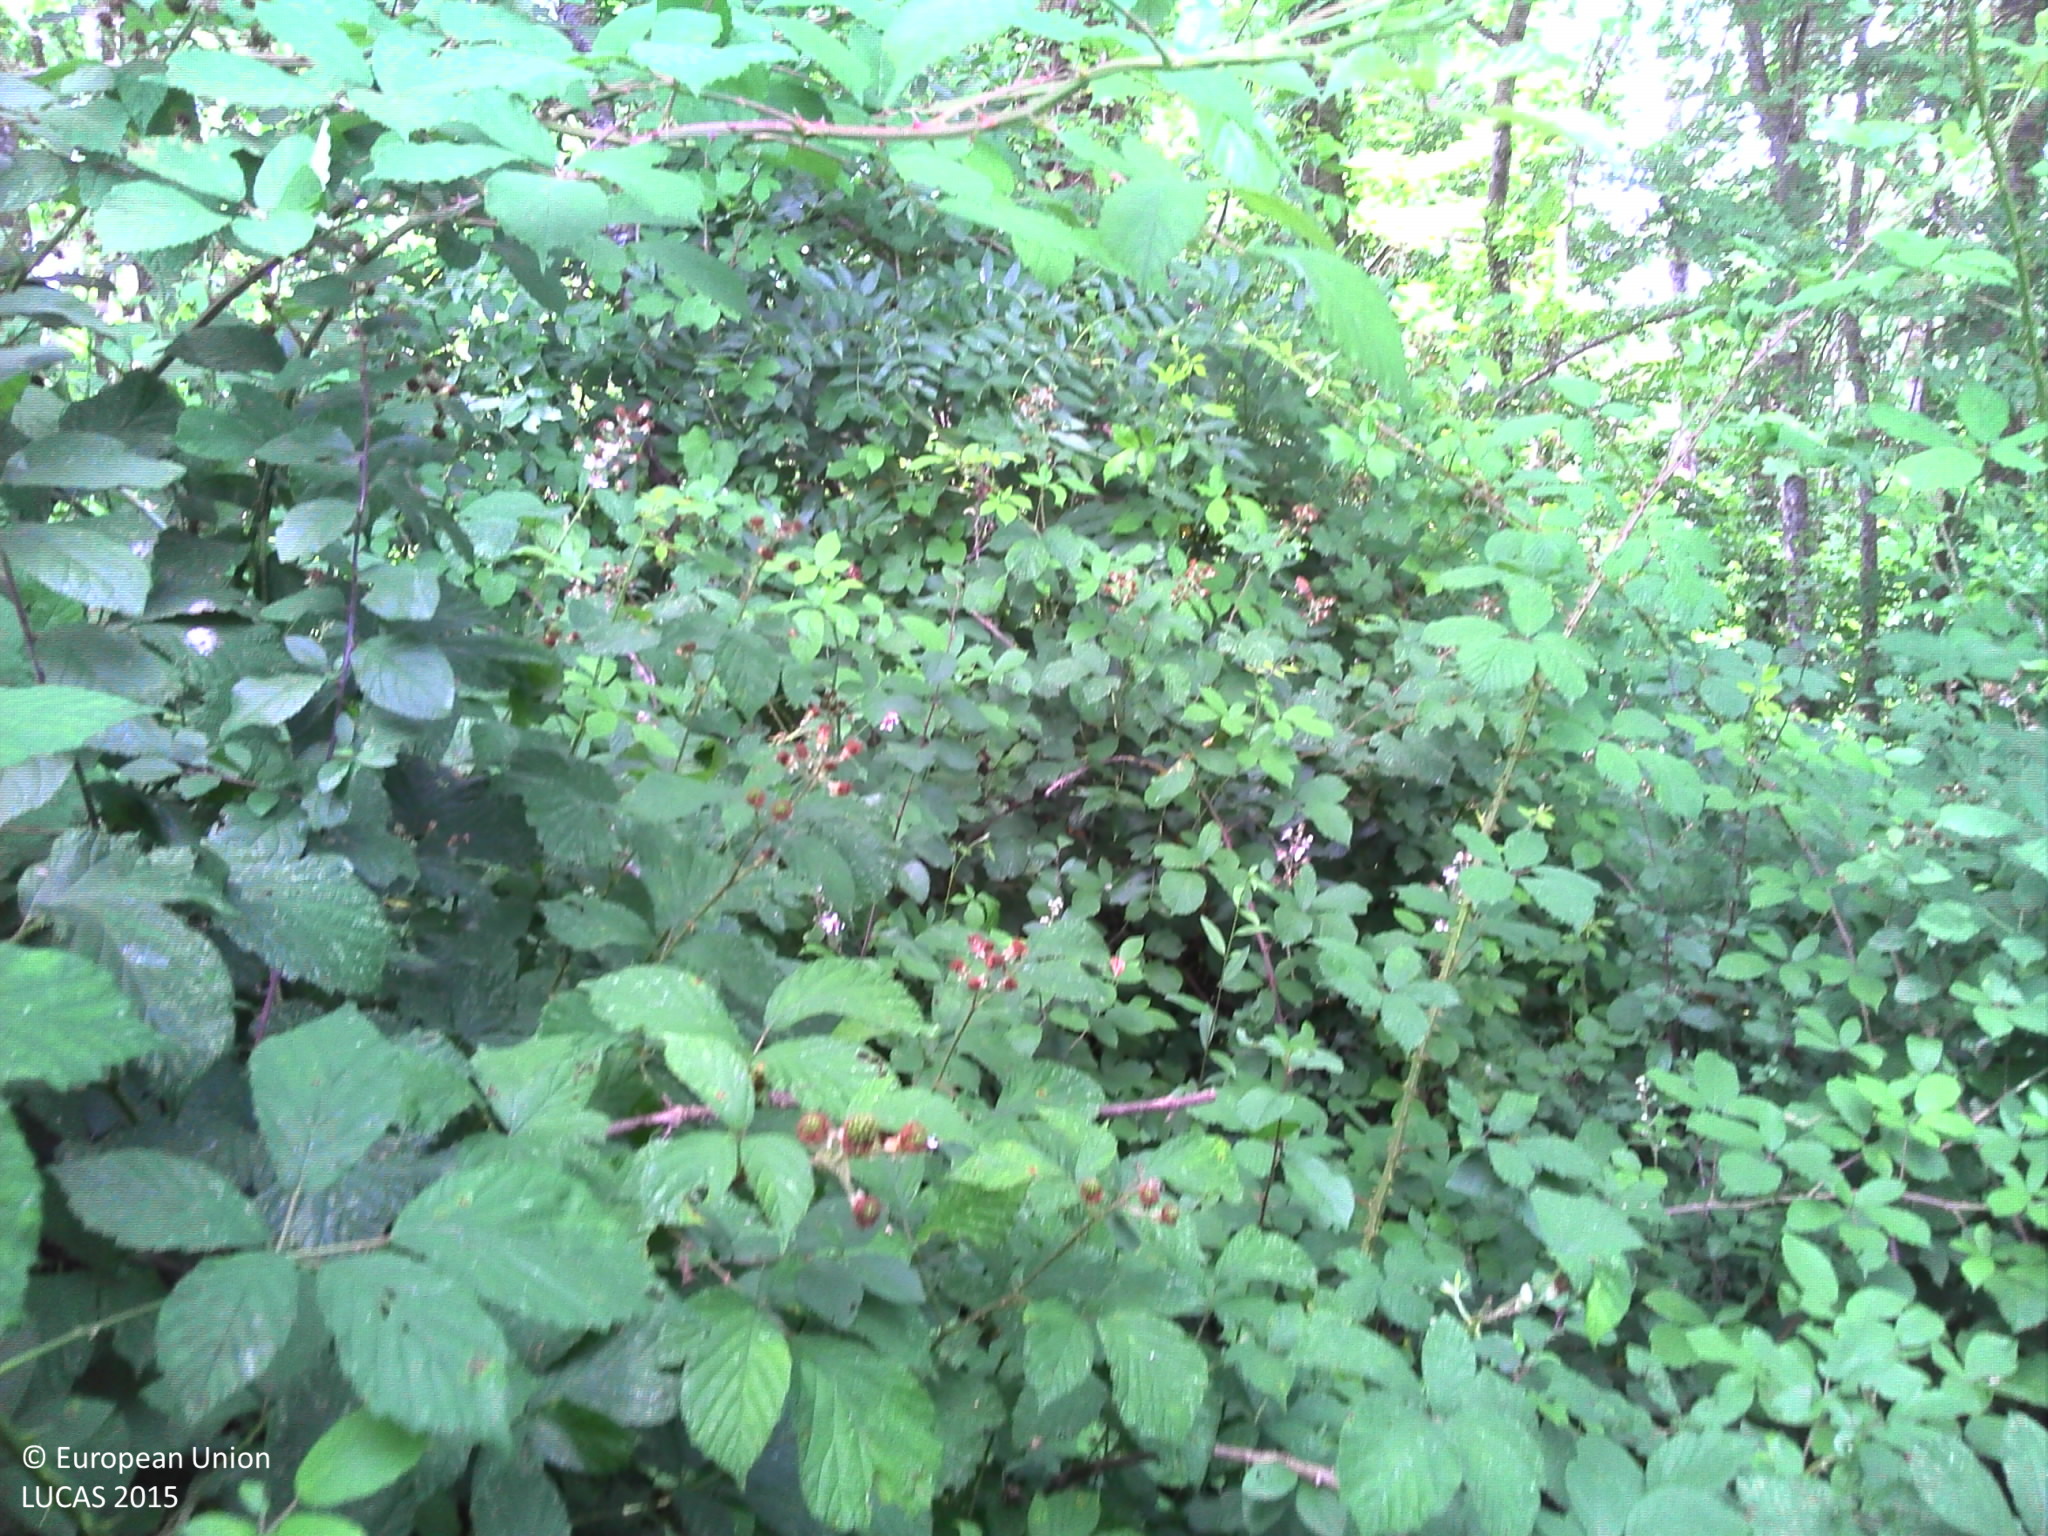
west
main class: Woodland
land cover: Broadleaved woodland
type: acidophilous oak and oak-birch forest
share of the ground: > 75 %
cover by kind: broadleaved forest trees 70 %, shrubs 20 %, herbaceous plants 10 %
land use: Forestry
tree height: > 5 m
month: June
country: FR
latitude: 46.4477
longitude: 5.3292
